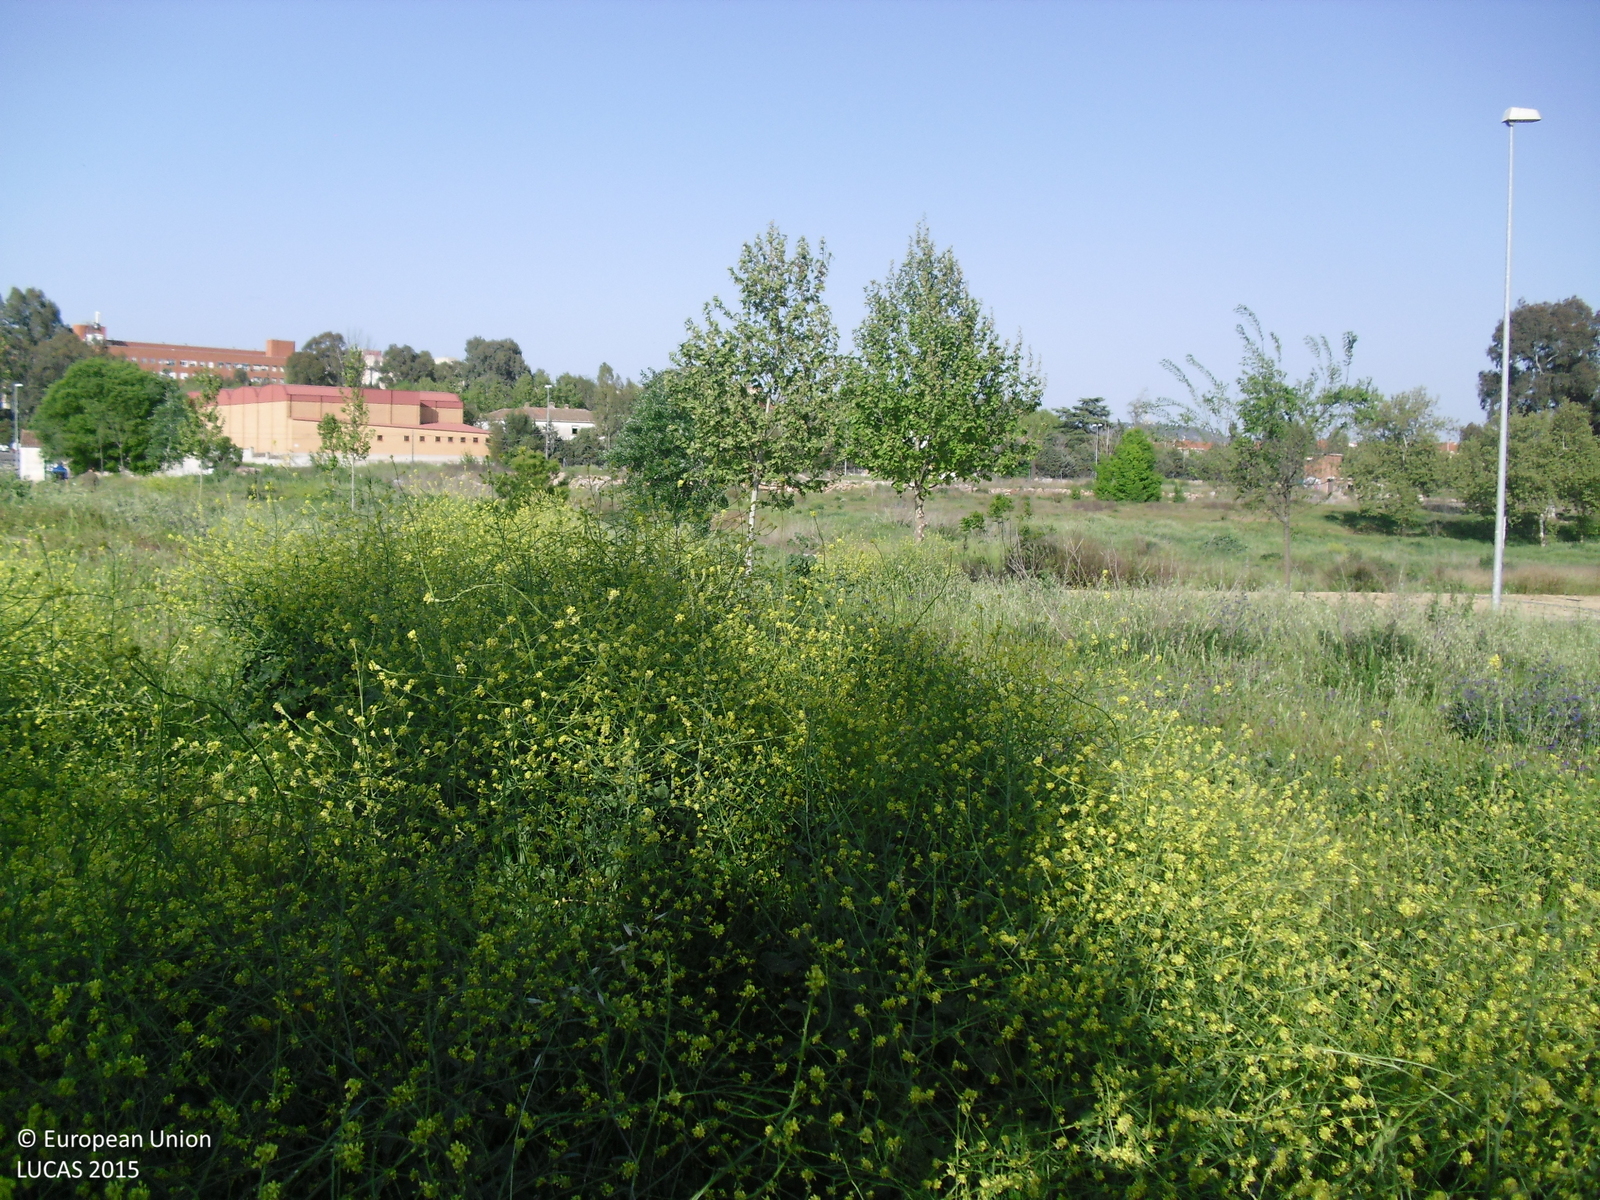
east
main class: Grassland
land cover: Grassland with sparse tree/shrub cover
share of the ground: > 75 %
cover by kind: herbaceous plants 95 %, broadleaved forest trees 5 %
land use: Abandoned areas
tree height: < 5 m
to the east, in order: Grassland with sparse tree/shrub cover; Tracks; Paved roads, cycling and walking lanes; Grassland without tree/shrub cover; Groves; Grassland without tree/shrub cover; Railways; Dry stone walls; Electric lines; Artificial constructions in urban areas; Grassland without tree/shrub cover
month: April
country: ES
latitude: 39.4486
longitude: -6.3946
